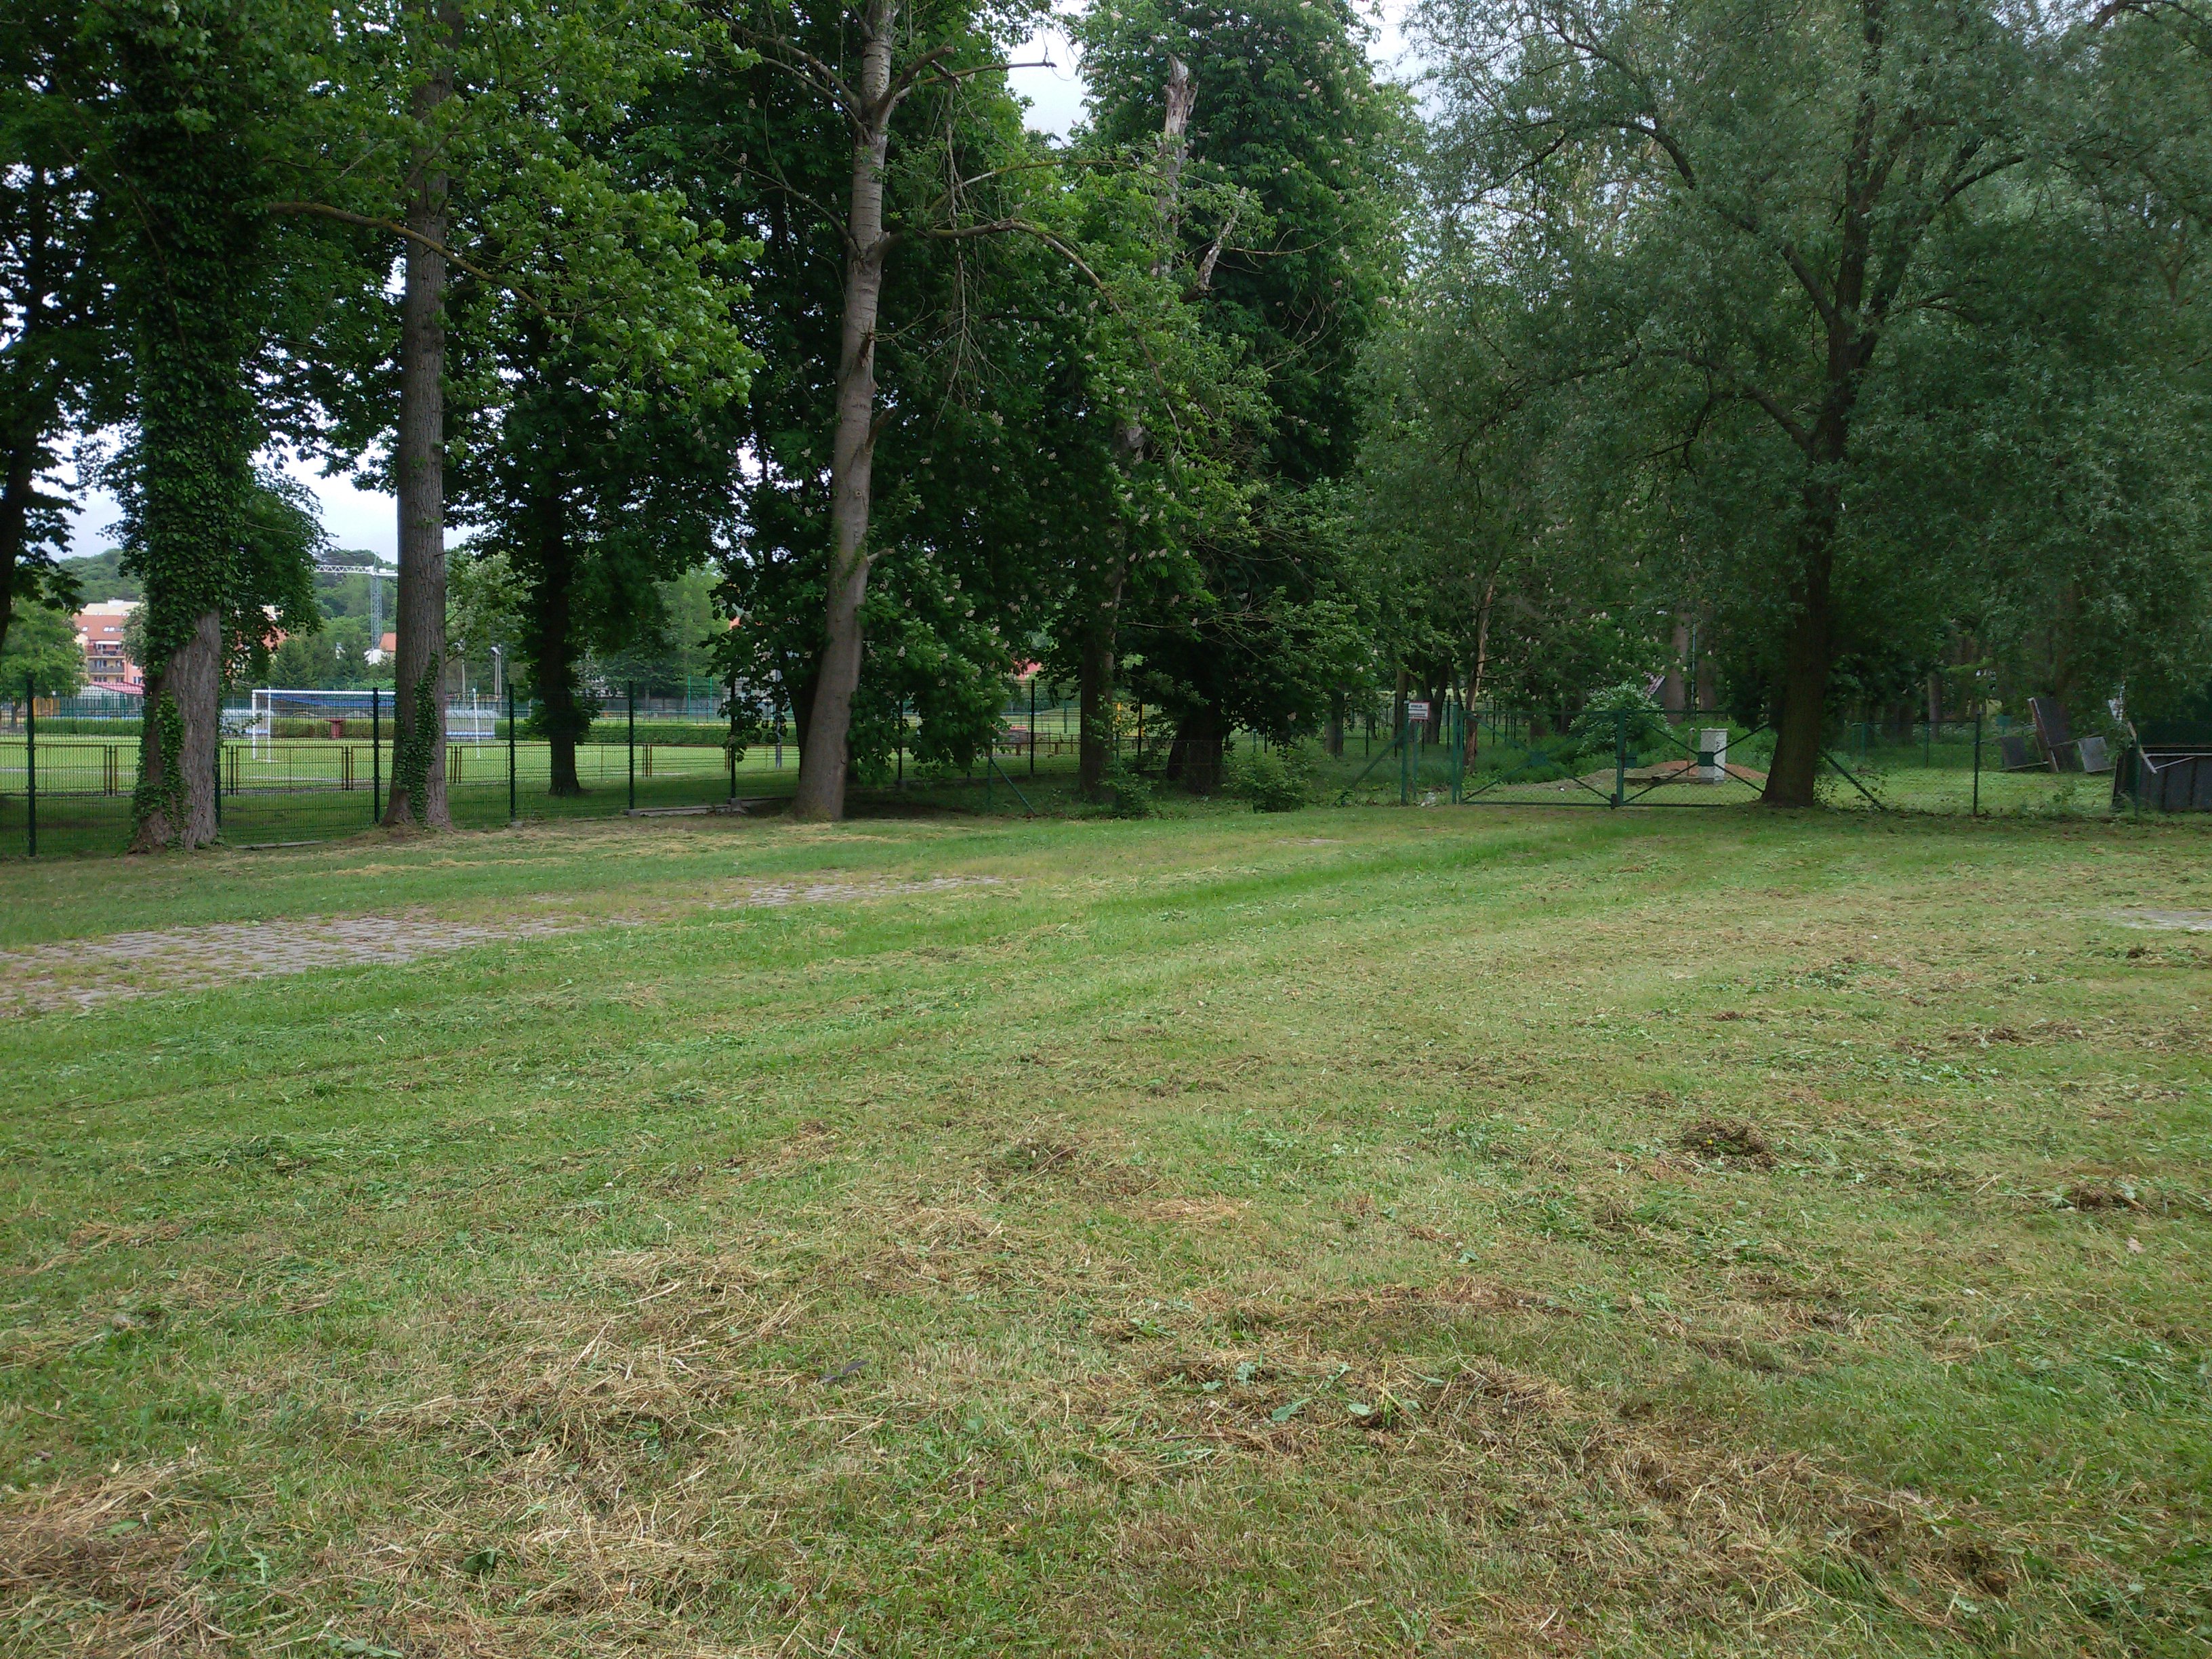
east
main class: Grassland
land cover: Grassland with sparse tree/shrub cover
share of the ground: > 75 %
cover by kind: herbaceous plants 95 %, broadleaved forest trees 5 %
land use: Amenities, museums, leisure
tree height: > 5 m
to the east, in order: Grassland with sparse tree/shrub cover; Artificial constructions in urban areas
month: May
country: PL
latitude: 53.2470
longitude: 14.4821
